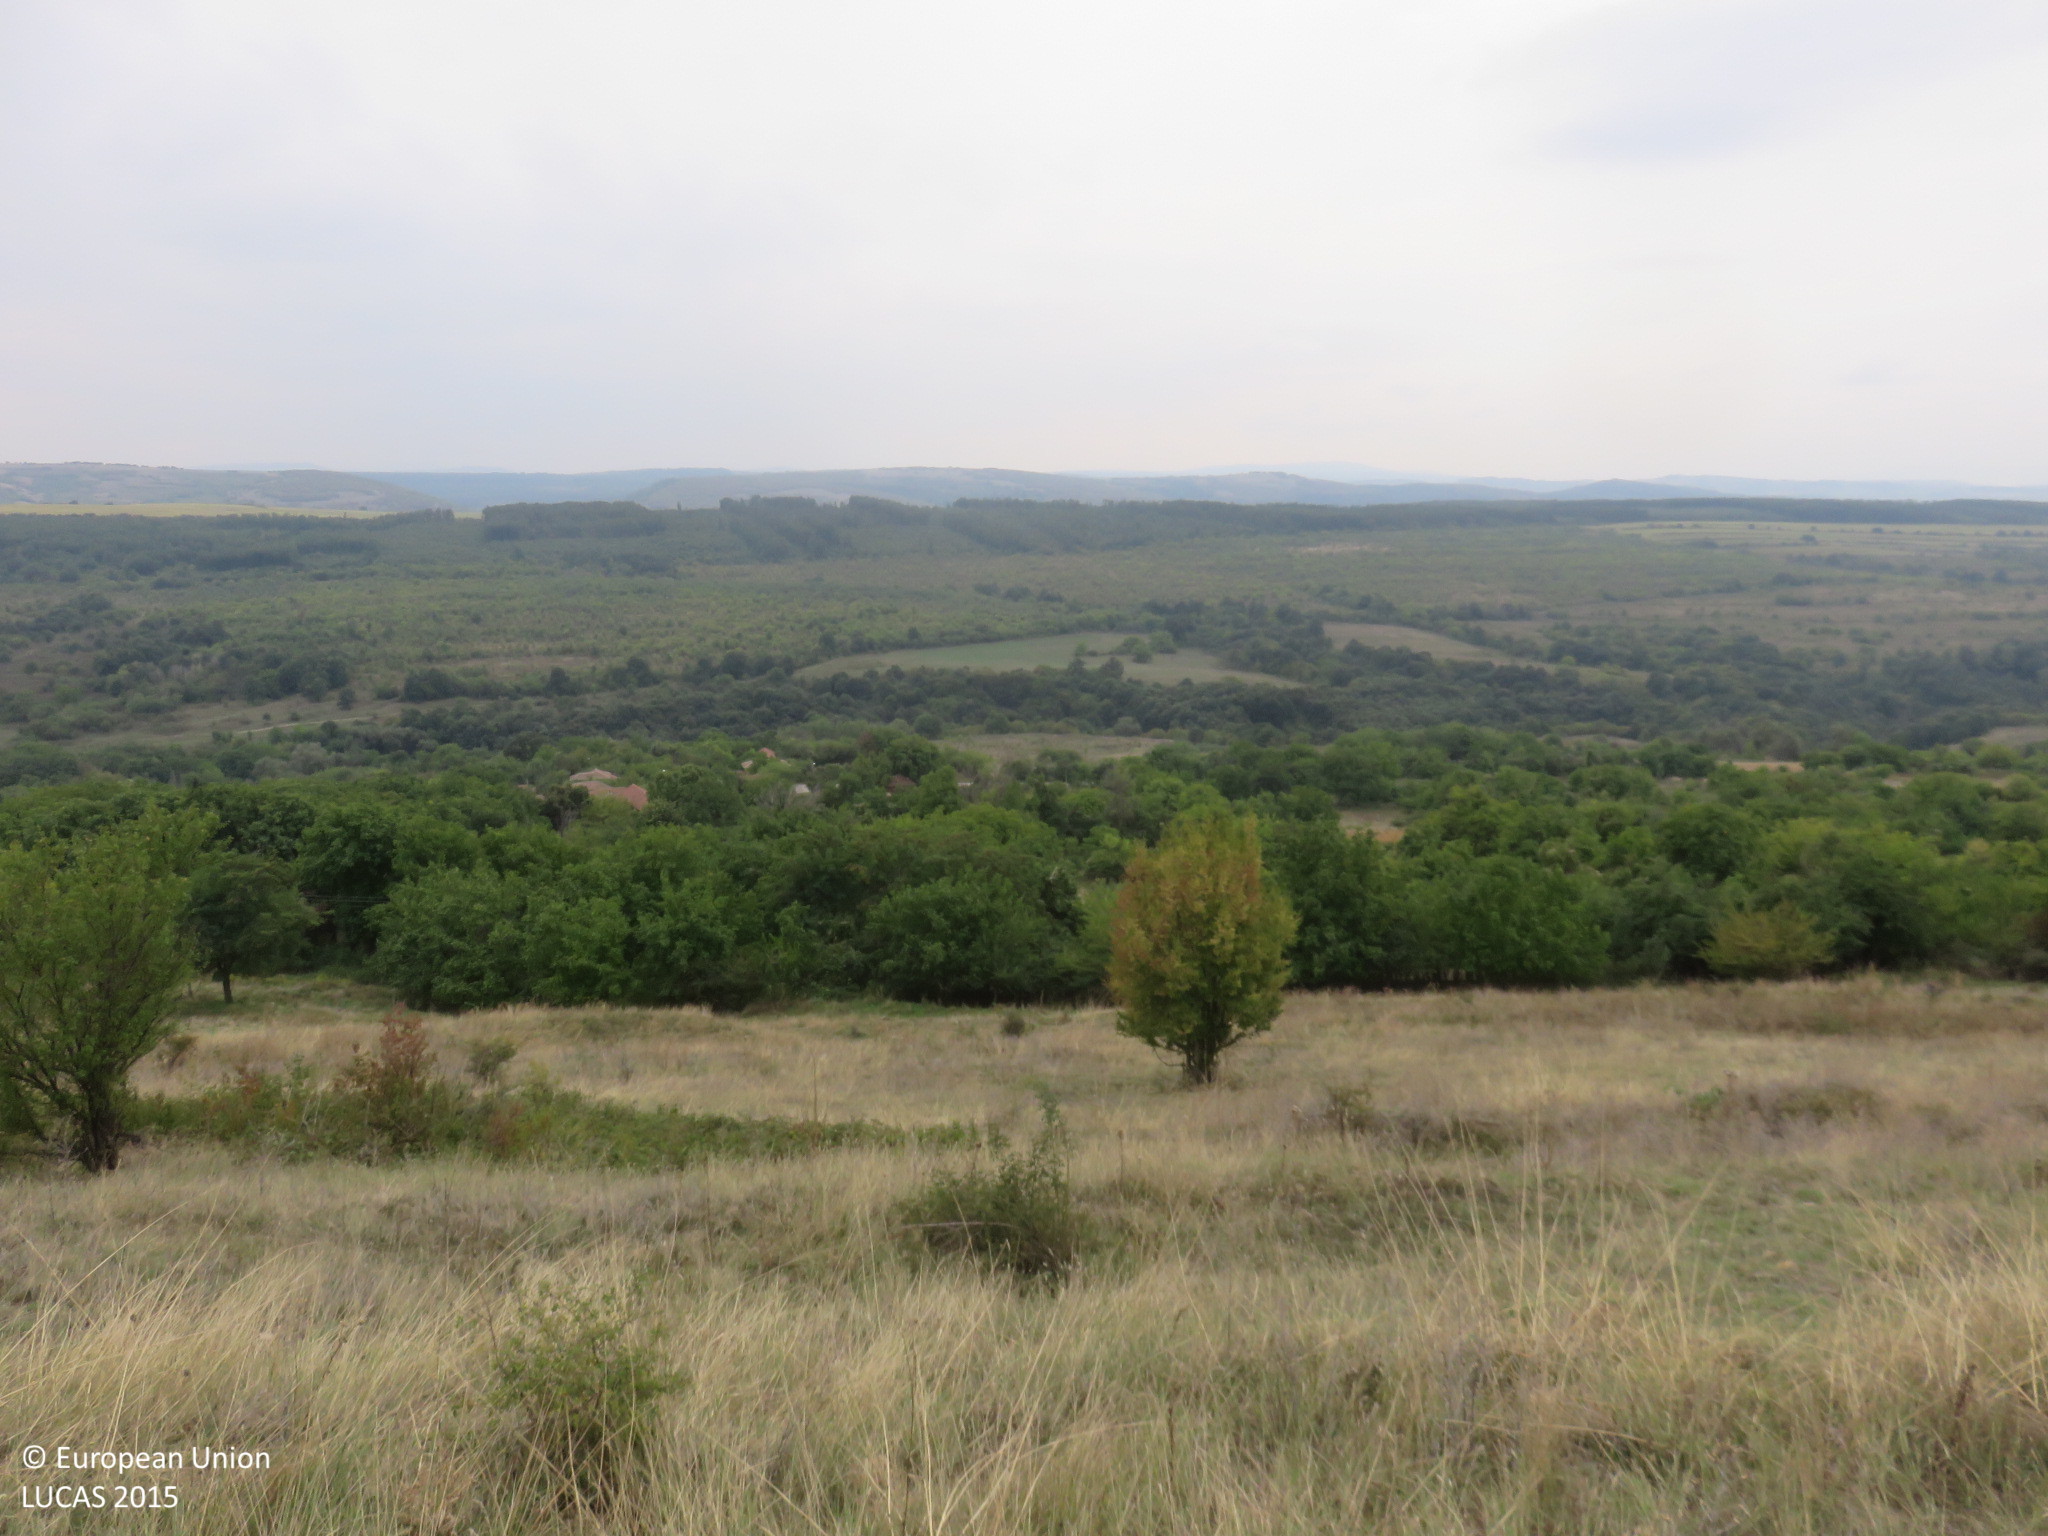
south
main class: Grassland
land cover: Grassland with sparse tree/shrub cover
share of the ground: > 75 %
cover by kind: herbaceous plants 90 %, broadleaved forest trees 5 %, shrubs 5 %
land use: Agriculture (excluding fallow land and kitchen gardens)
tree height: < 5 m
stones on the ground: 10 - 25 %
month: September
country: BG
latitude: 43.1776
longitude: 24.8898
